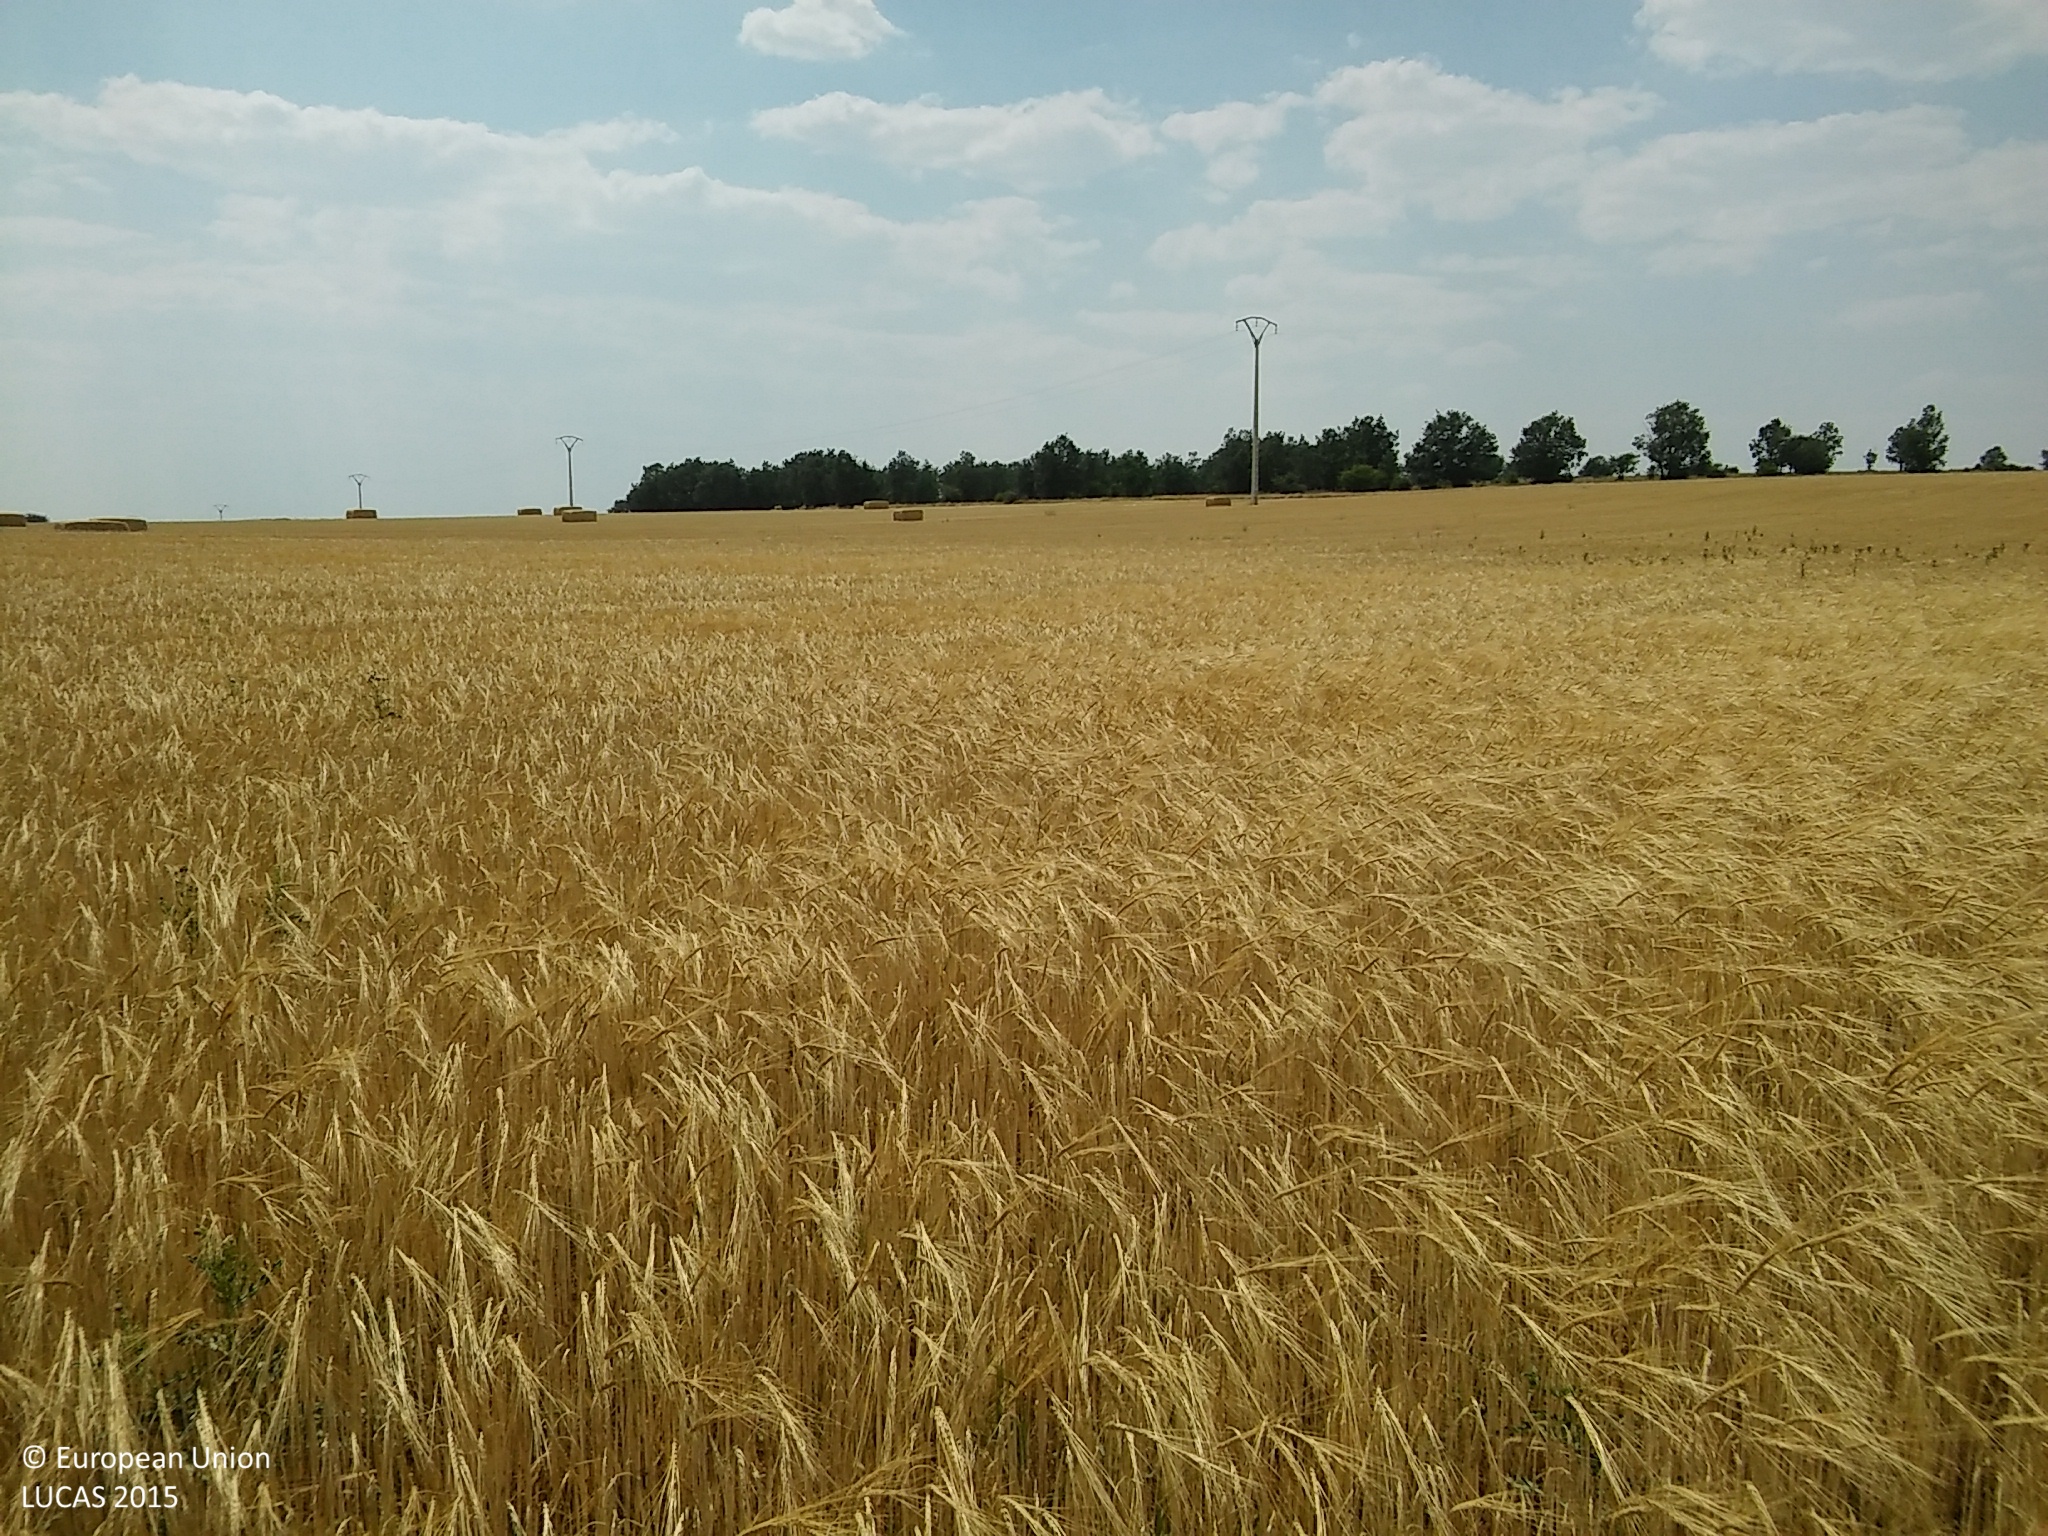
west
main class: Cropland
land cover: Barley
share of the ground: > 75 %
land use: Agriculture (excluding fallow land and kitchen gardens)
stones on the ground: 10 - 25 %
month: June
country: ES
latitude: 41.3848
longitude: -3.5969
